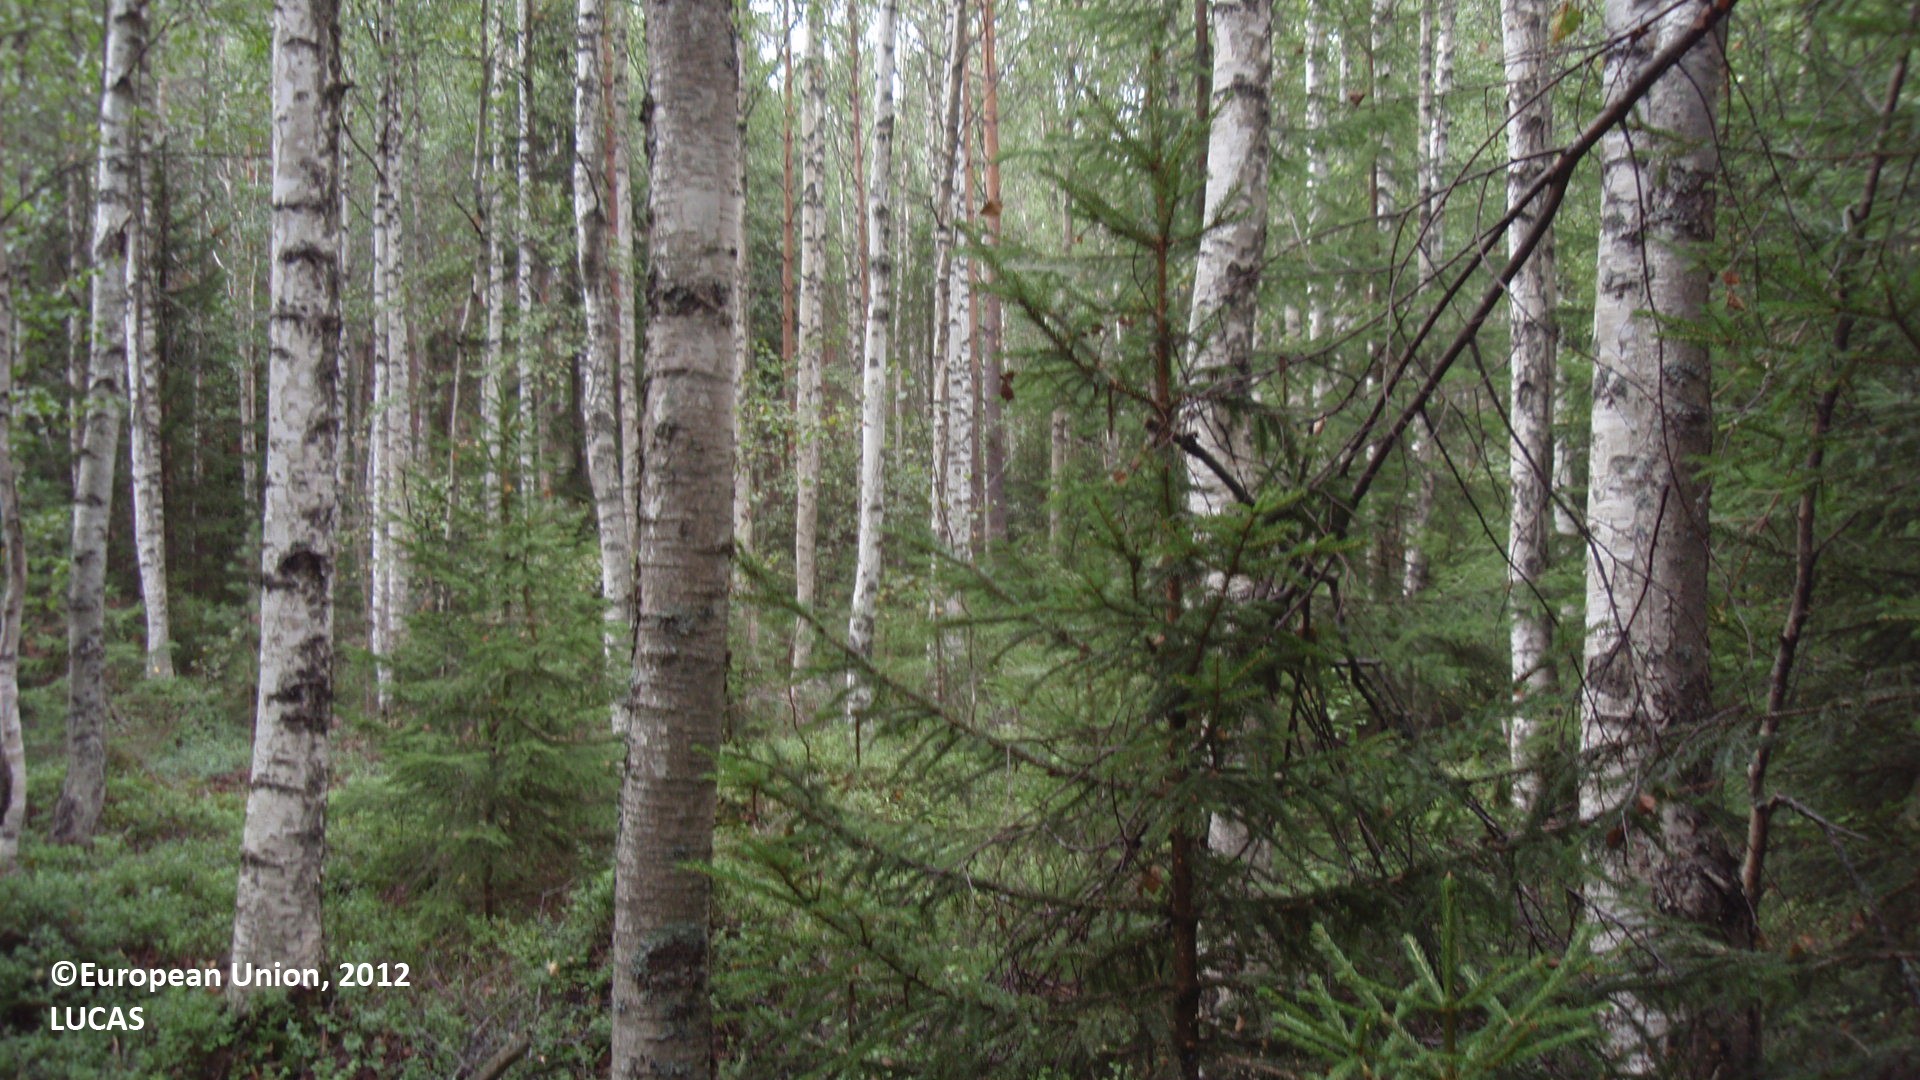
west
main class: Woodland
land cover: Pine dominated mixed woodland
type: boreal forest
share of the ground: > 75 %
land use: Forestry
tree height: > 5 m
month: August
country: FI
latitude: 60.9328
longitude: 27.5858
